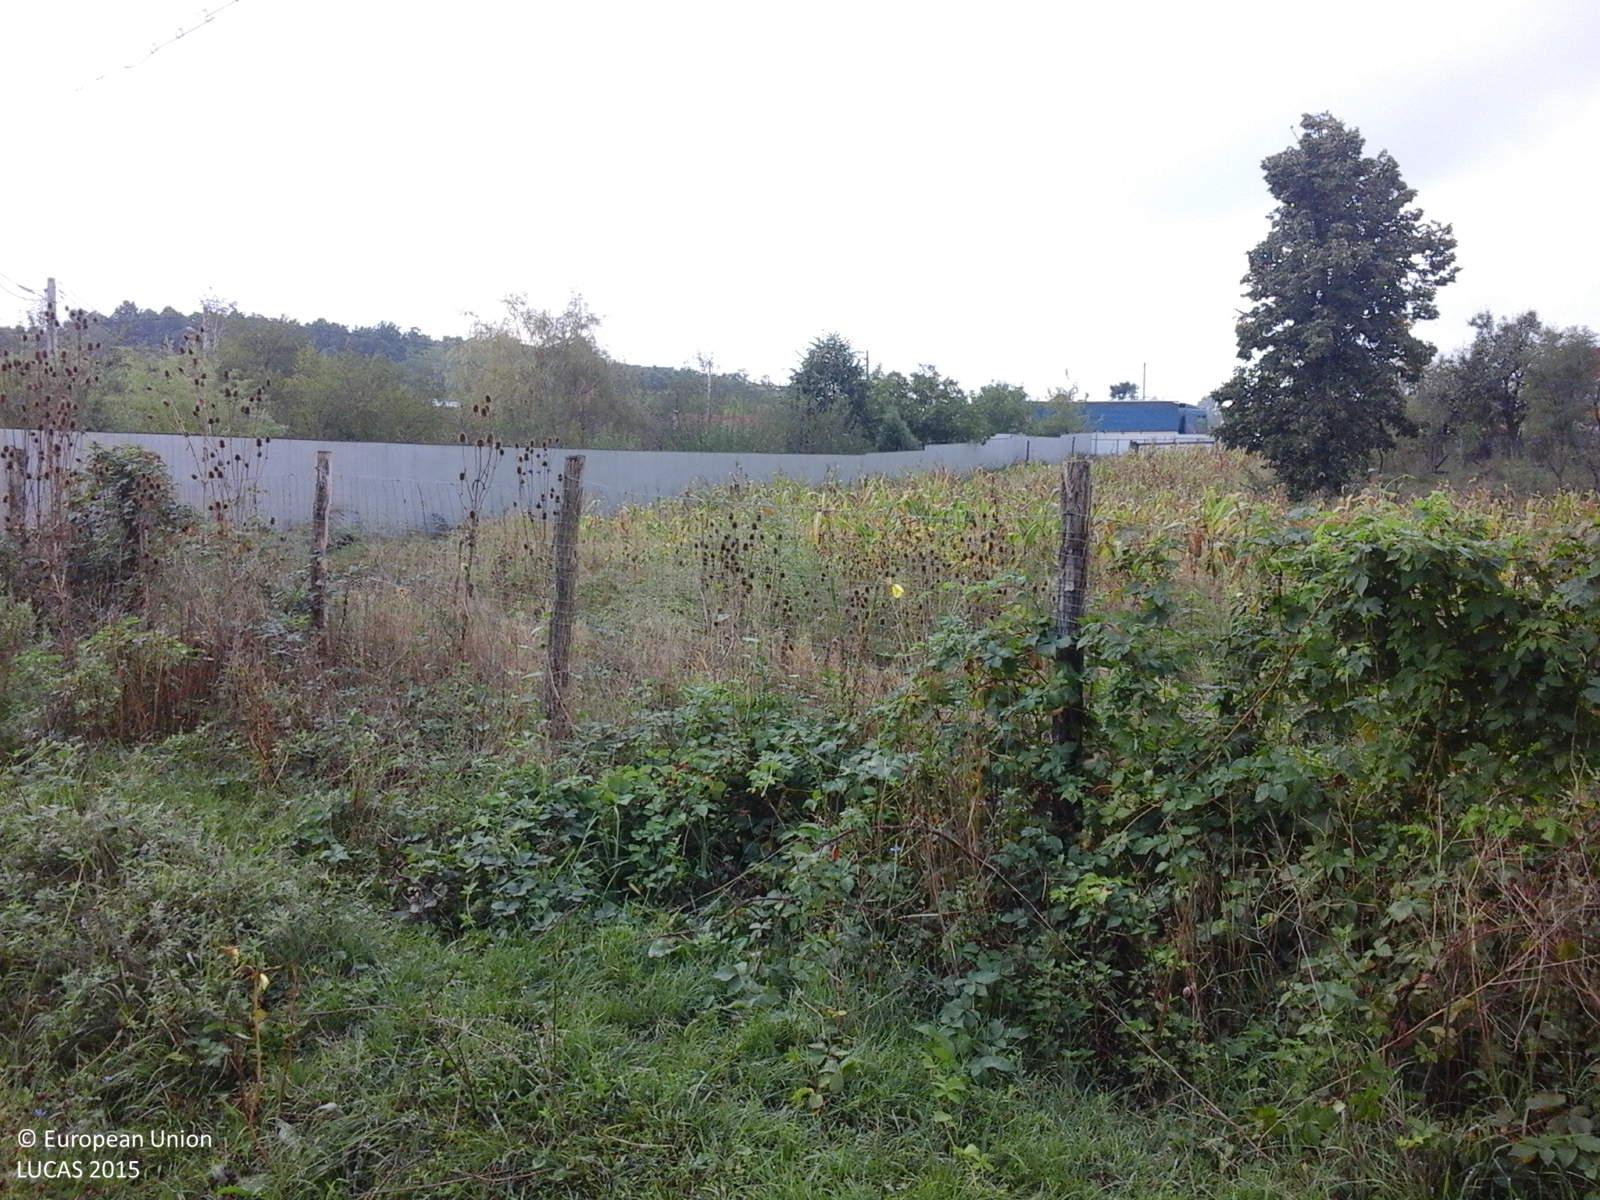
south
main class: Cropland
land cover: Maize
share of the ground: > 75 %
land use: Agriculture (excluding fallow land and kitchen gardens)
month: September
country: RO
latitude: 45.0231
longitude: 23.4455
